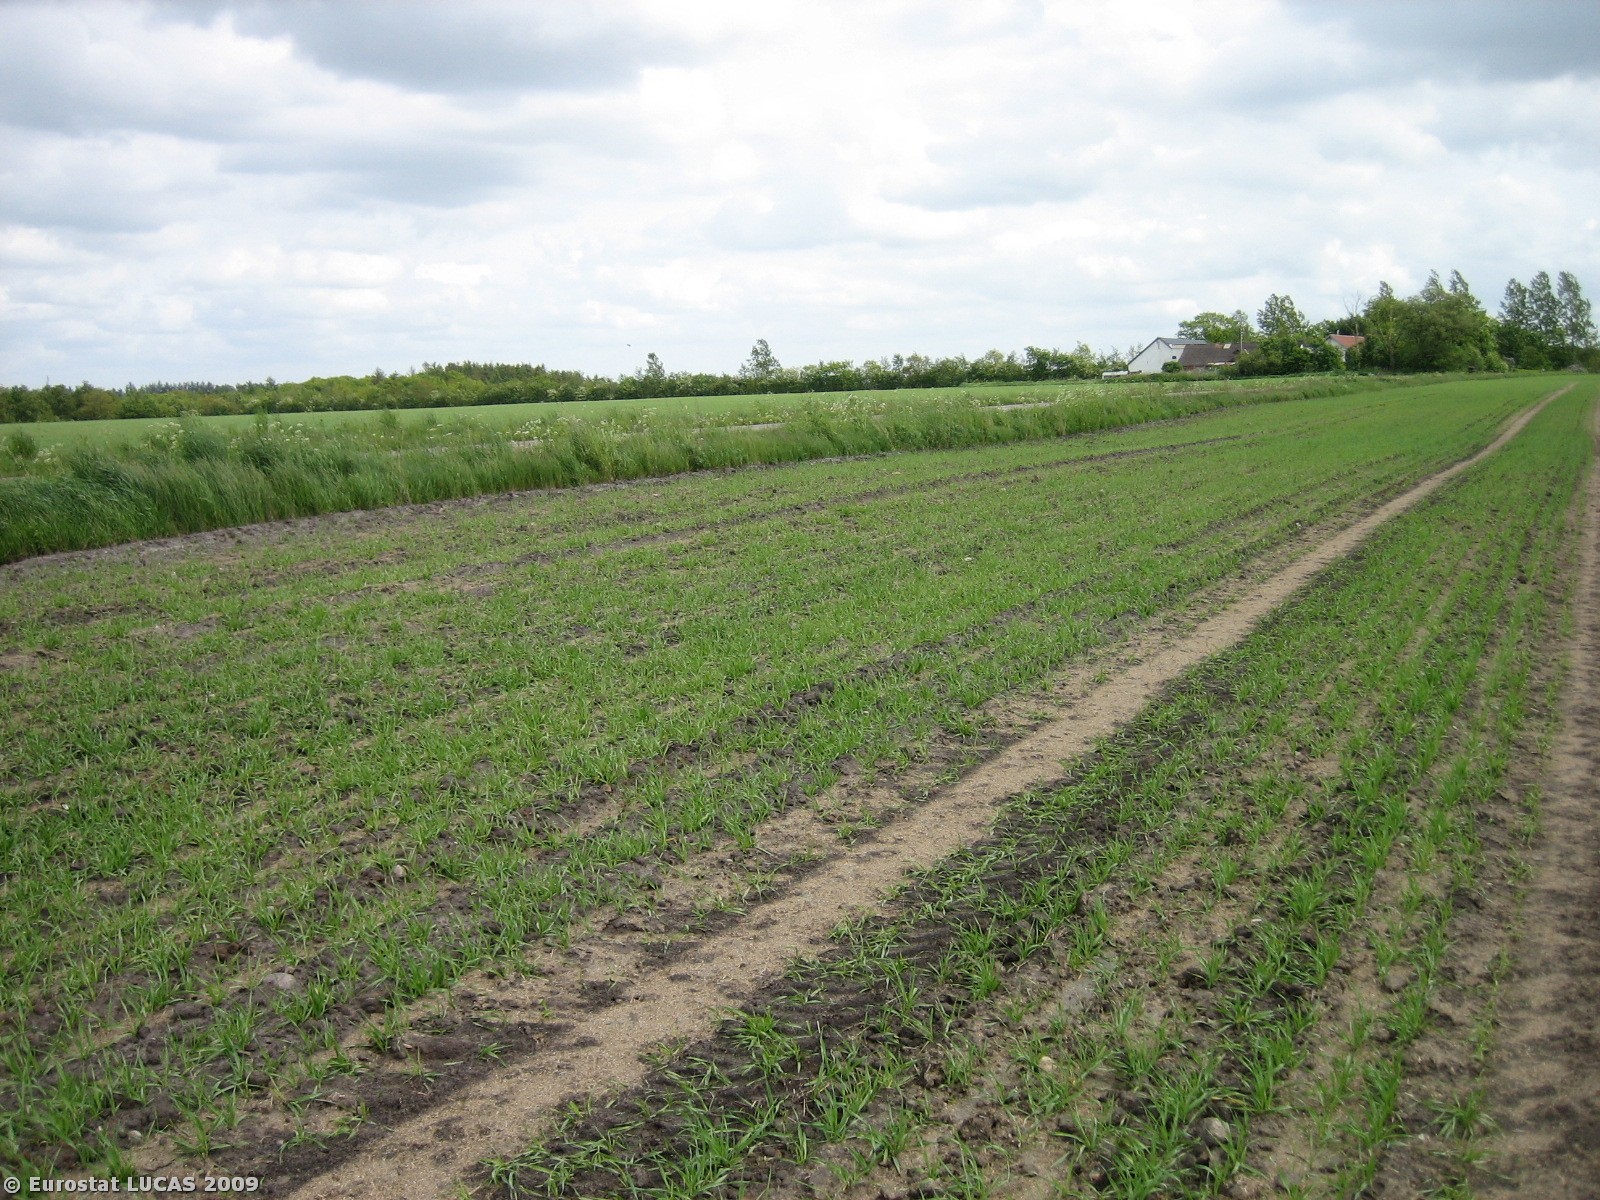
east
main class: Cropland
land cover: Barley
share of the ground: 50 - 75 %
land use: Agriculture (excluding fallow land and kitchen gardens)
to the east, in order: Barley; Ditches and canals; Grass margins; Paved roads, cycling and walking lanes; Ditches and canals; Grass margins; Barley
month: May
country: DK
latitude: 56.1829
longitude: 8.8896
